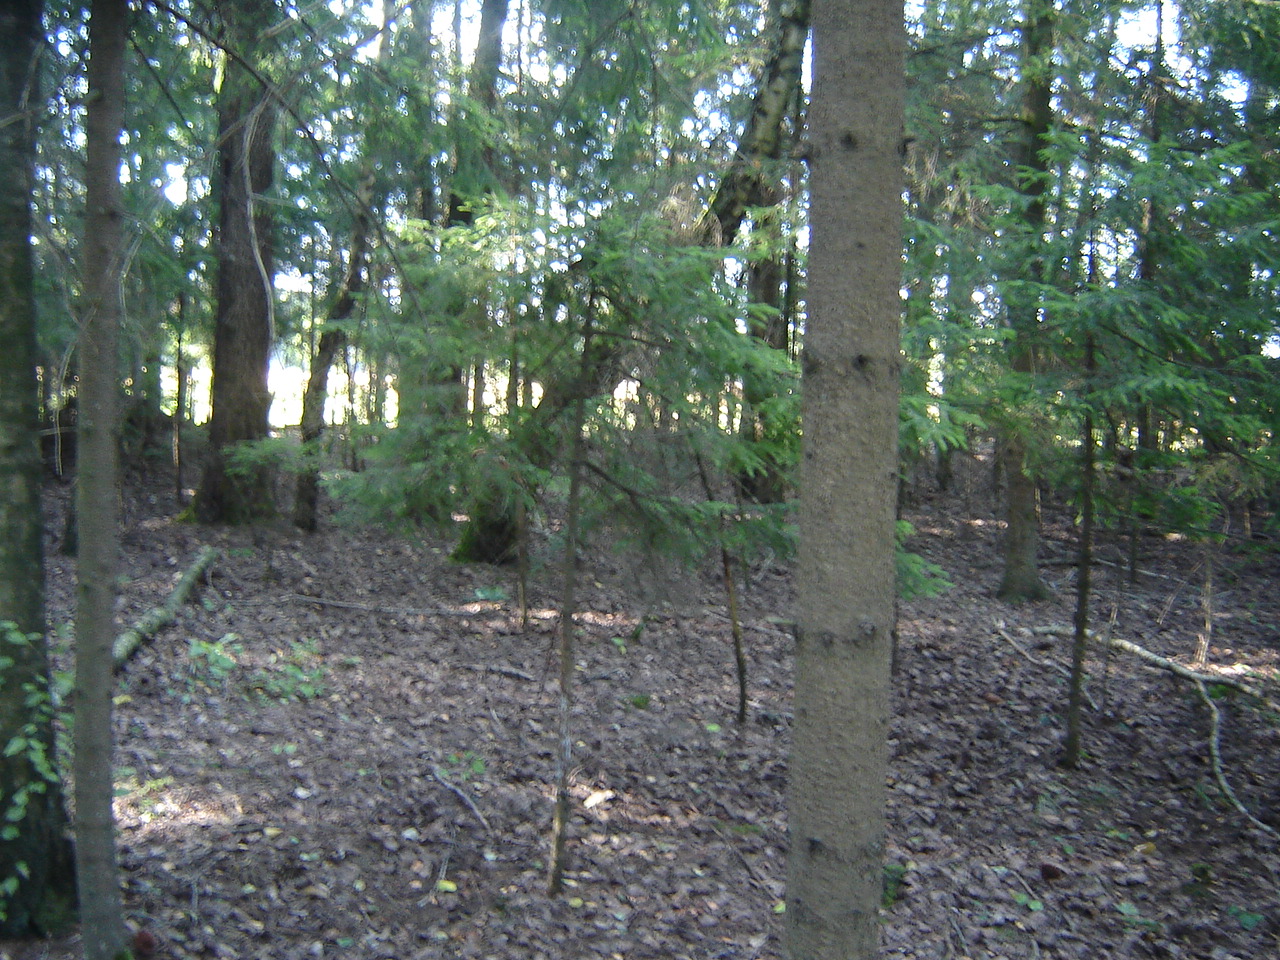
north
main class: Woodland
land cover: Spruce dominated mixed woodland
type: hemiboreal forest and nemoral coniferous forest and mixed broadleaved-coniferous forest
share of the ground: > 75 %
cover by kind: coniferous forest trees 60 %, broadleaved forest trees 30 %, herbaceous plants 5 %, unconsolidated bare surface 5 %
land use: Forestry
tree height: > 5 m
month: August
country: LT
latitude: 55.0363
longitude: 24.8974
